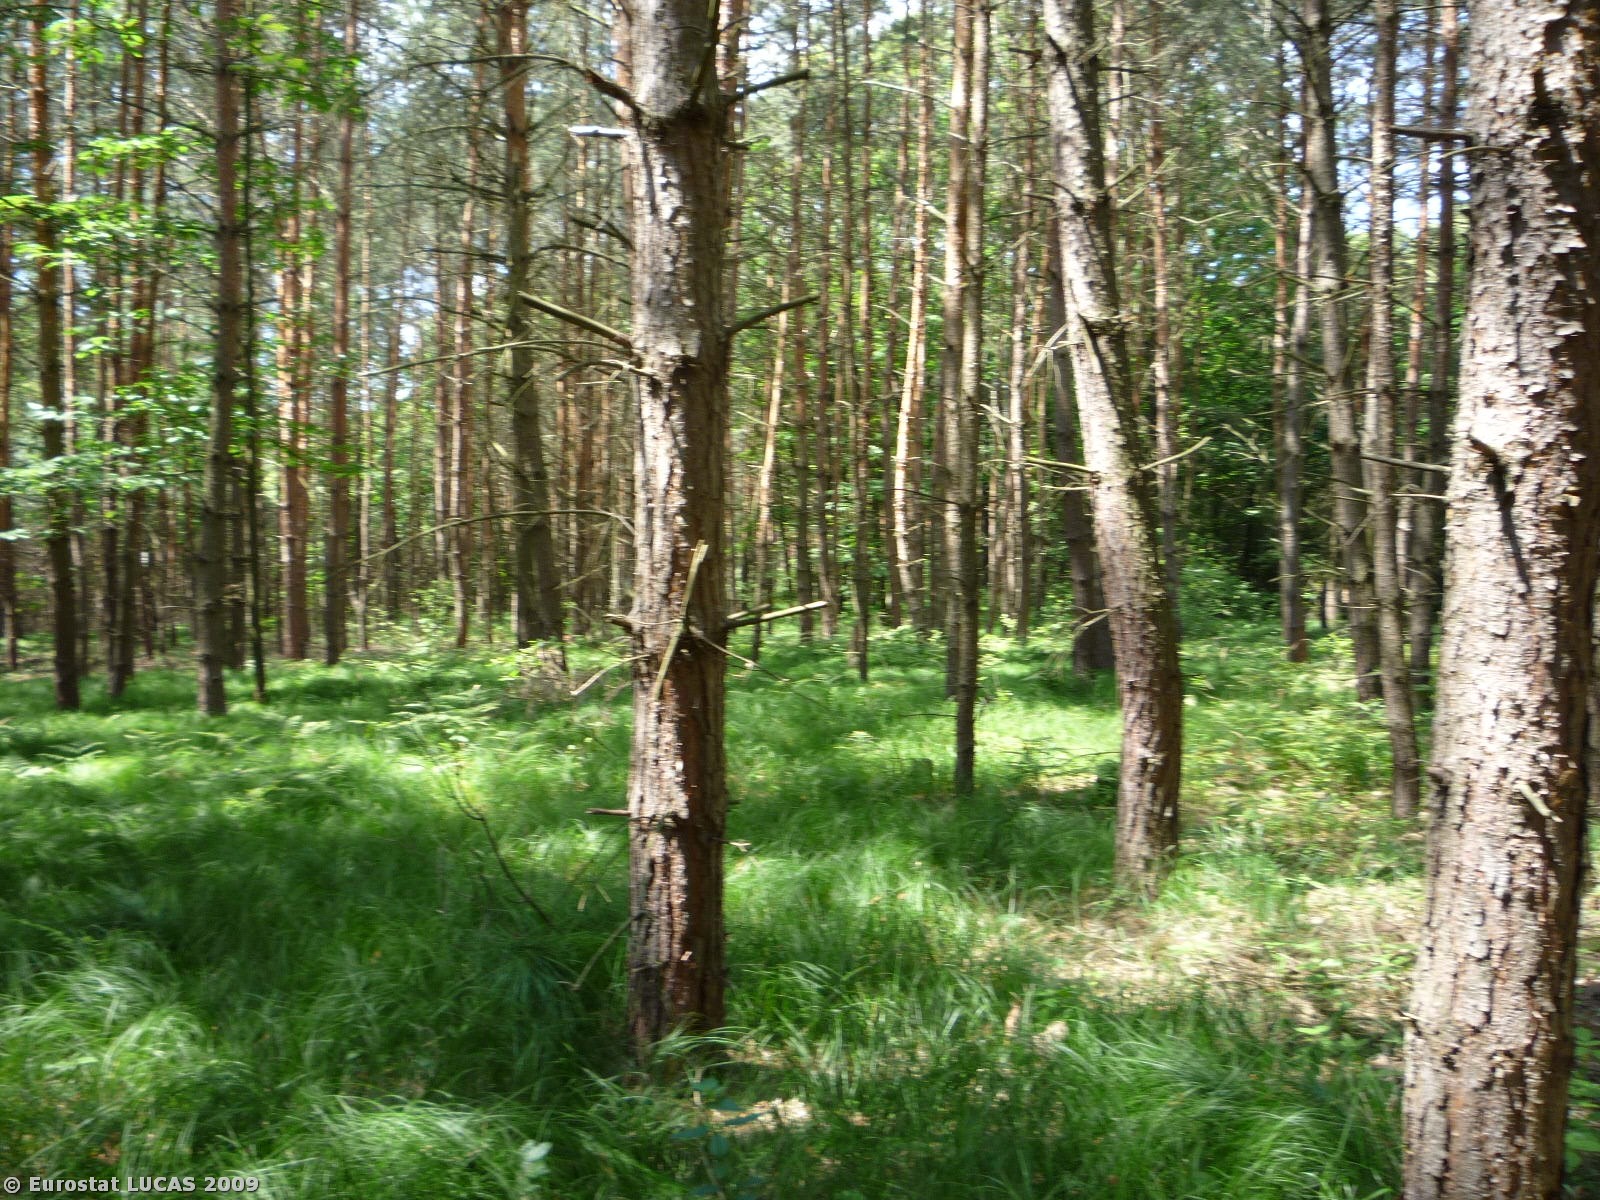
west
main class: Woodland
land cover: Coniferous woodland
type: hemiboreal forest and nemoral coniferous forest and mixed broadleaved-coniferous forest
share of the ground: > 75 %
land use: Forestry
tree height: > 5 m
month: June
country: CZ
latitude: 49.9802
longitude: 15.4845
